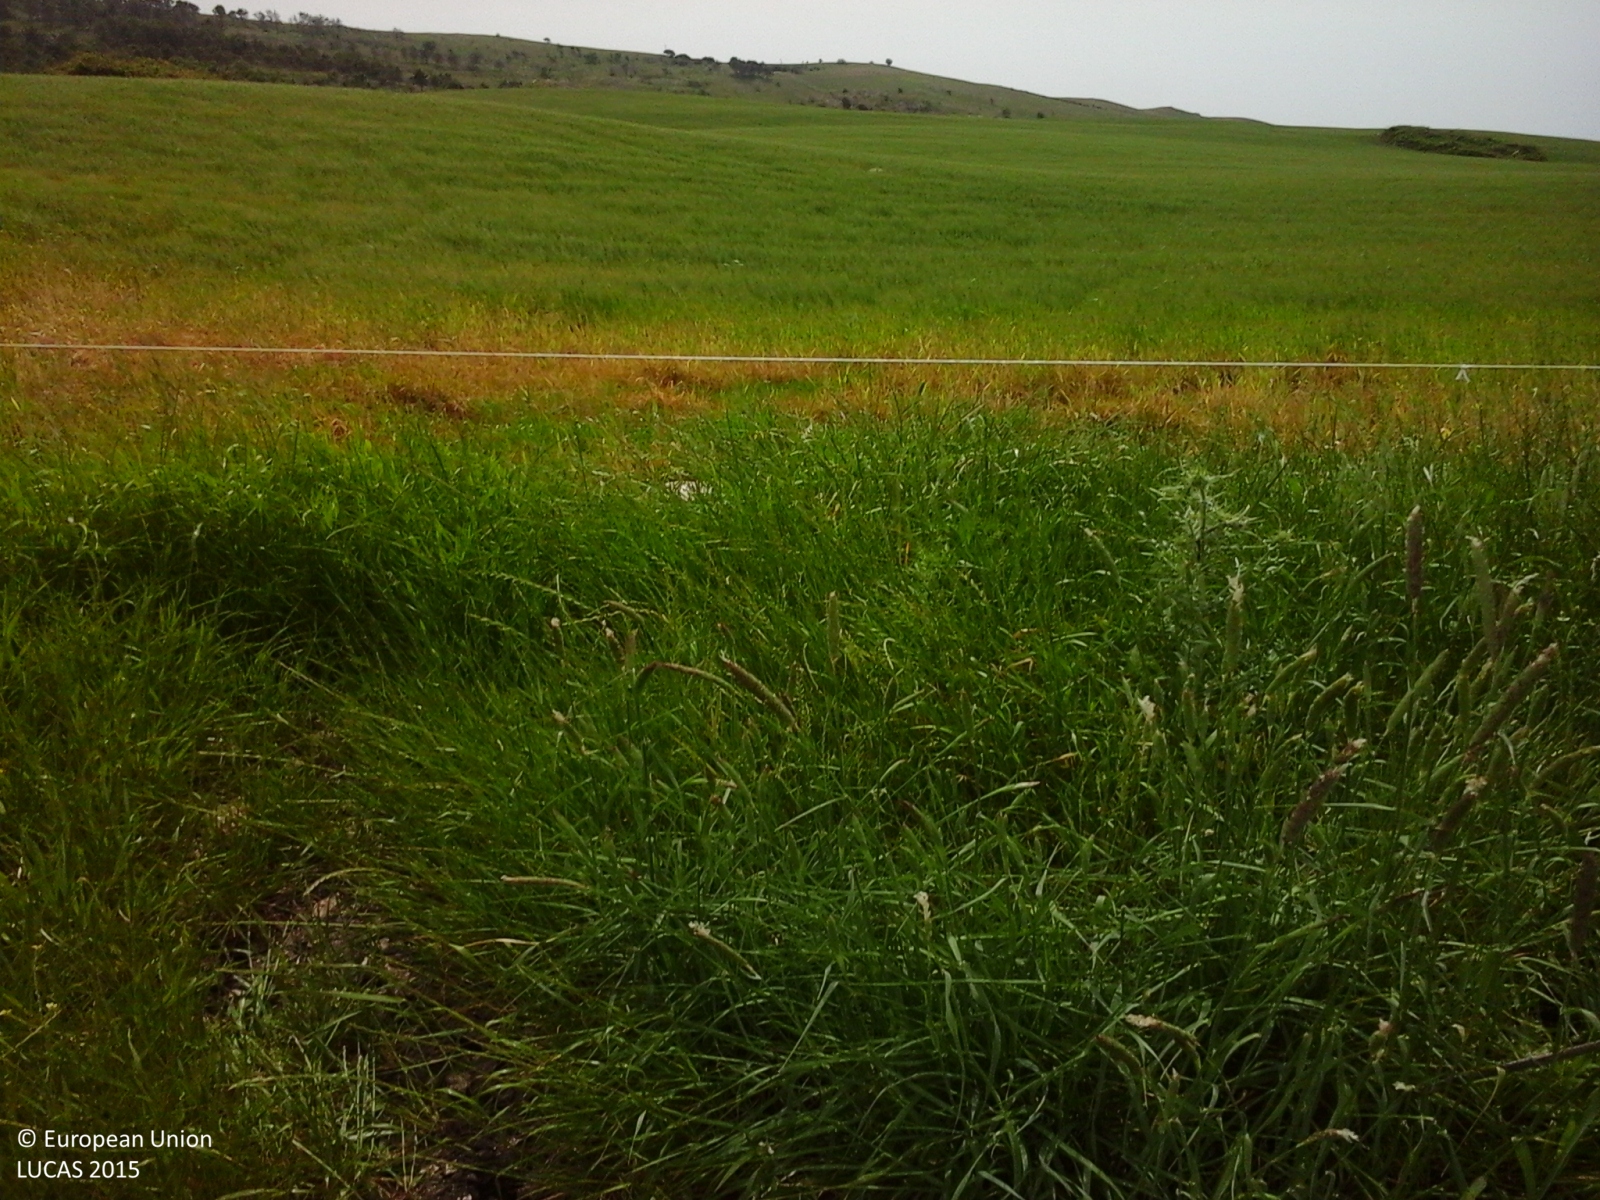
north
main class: Cropland
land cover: Durum wheat
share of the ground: > 75 %
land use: Agriculture (excluding fallow land and kitchen gardens)
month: May
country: IT
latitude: 37.7013
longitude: 13.5015
